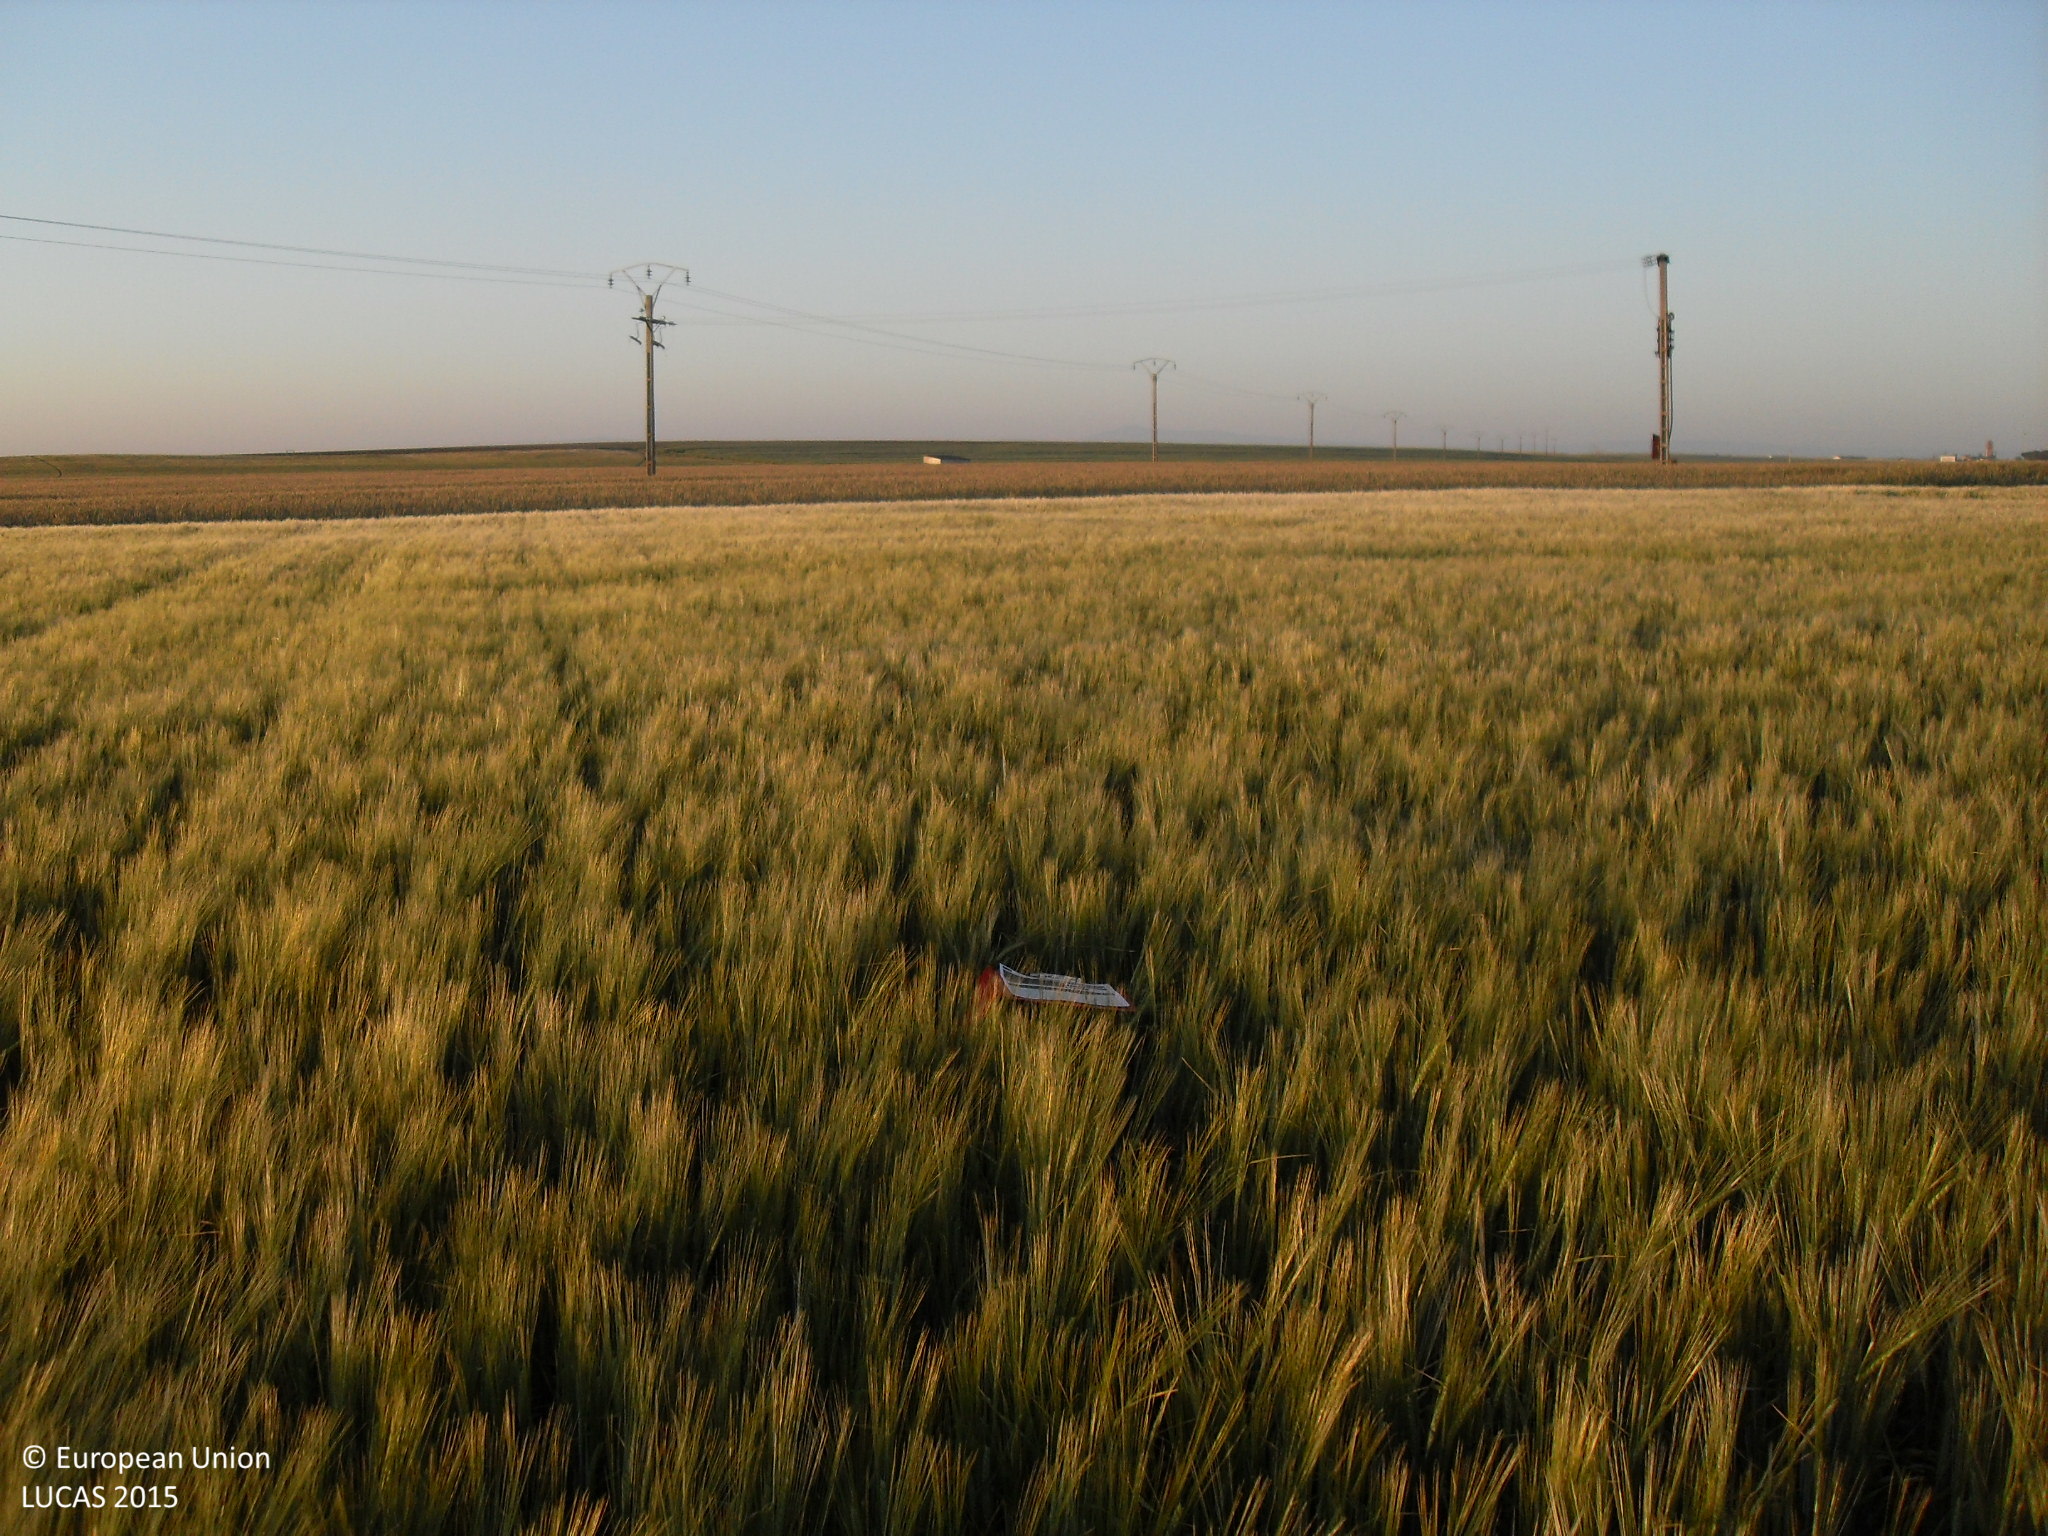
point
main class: Cropland
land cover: Barley
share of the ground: > 75 %
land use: Agriculture (excluding fallow land and kitchen gardens)
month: May
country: ES
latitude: 41.0420
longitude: -5.1892
